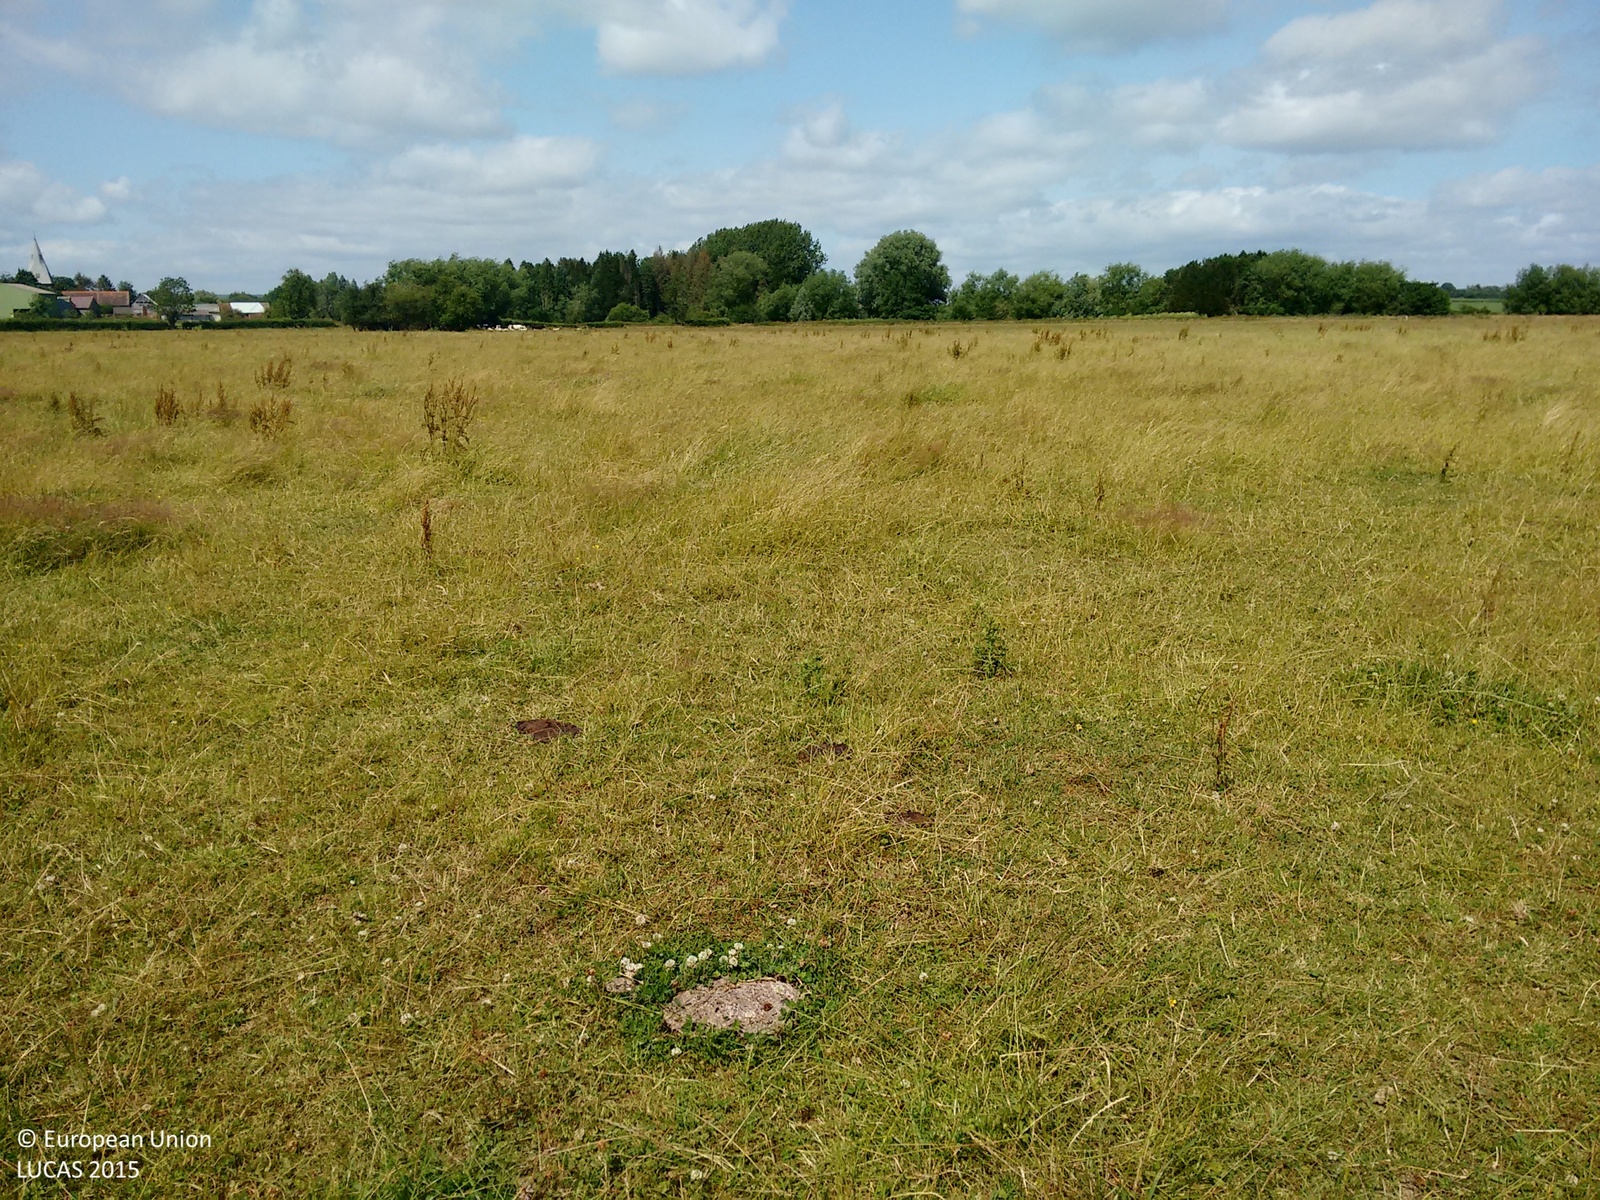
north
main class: Grassland
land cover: Grassland without tree/shrub cover
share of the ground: > 75 %
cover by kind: herbaceous plants 100 %
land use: Agriculture (excluding fallow land and kitchen gardens)
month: July
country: GB
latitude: 52.2103
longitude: -2.7888
